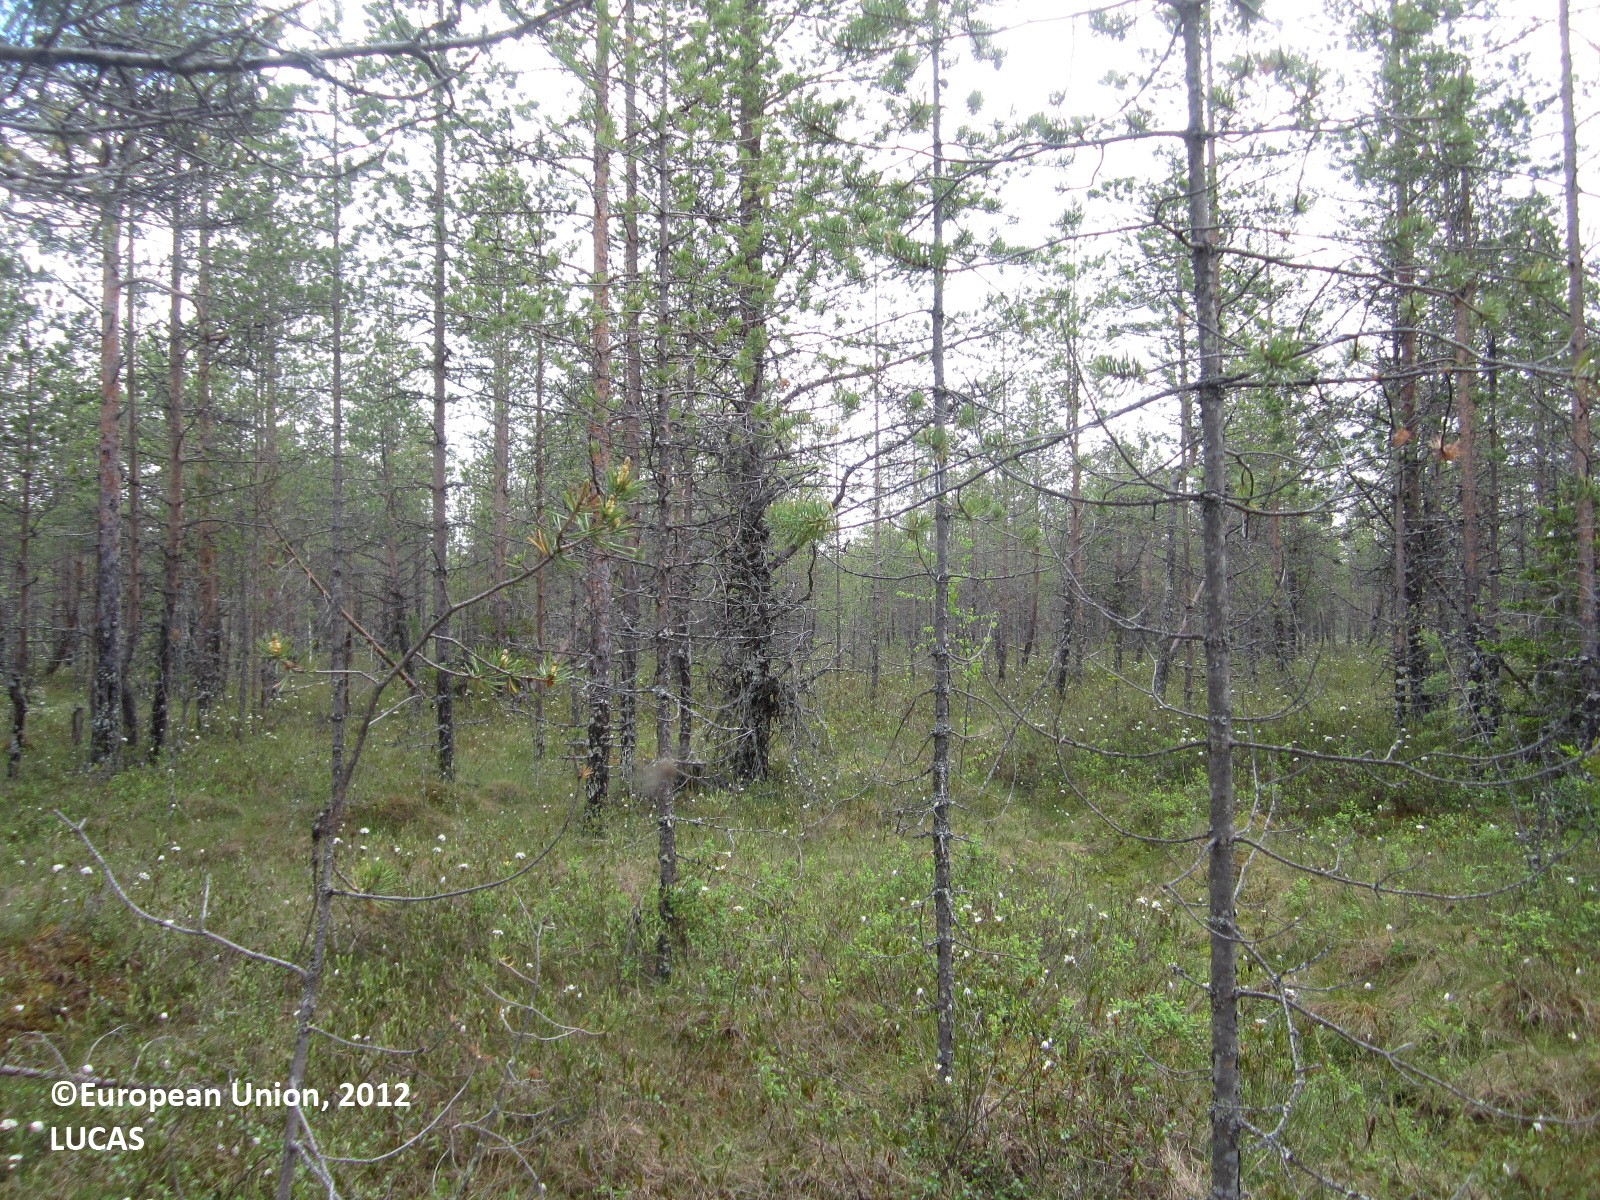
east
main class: Woodland
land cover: Pine dominated coniferous woodland
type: boreal forest
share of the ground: 50 - 75 %
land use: Forestry
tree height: > 5 m
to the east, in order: Pine dominated coniferous woodland; Ditches and canals; Pine dominated coniferous woodland; Ditches and canals; Grass margins; Pine dominated coniferous woodland; Ditches and canals; Pine dominated coniferous woodland; Ditches and canals; Grass margins; Pine dominated coniferous woodland; Peatbogs; Inland water bodies
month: June
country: FI
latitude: 64.4158
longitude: 29.7118
